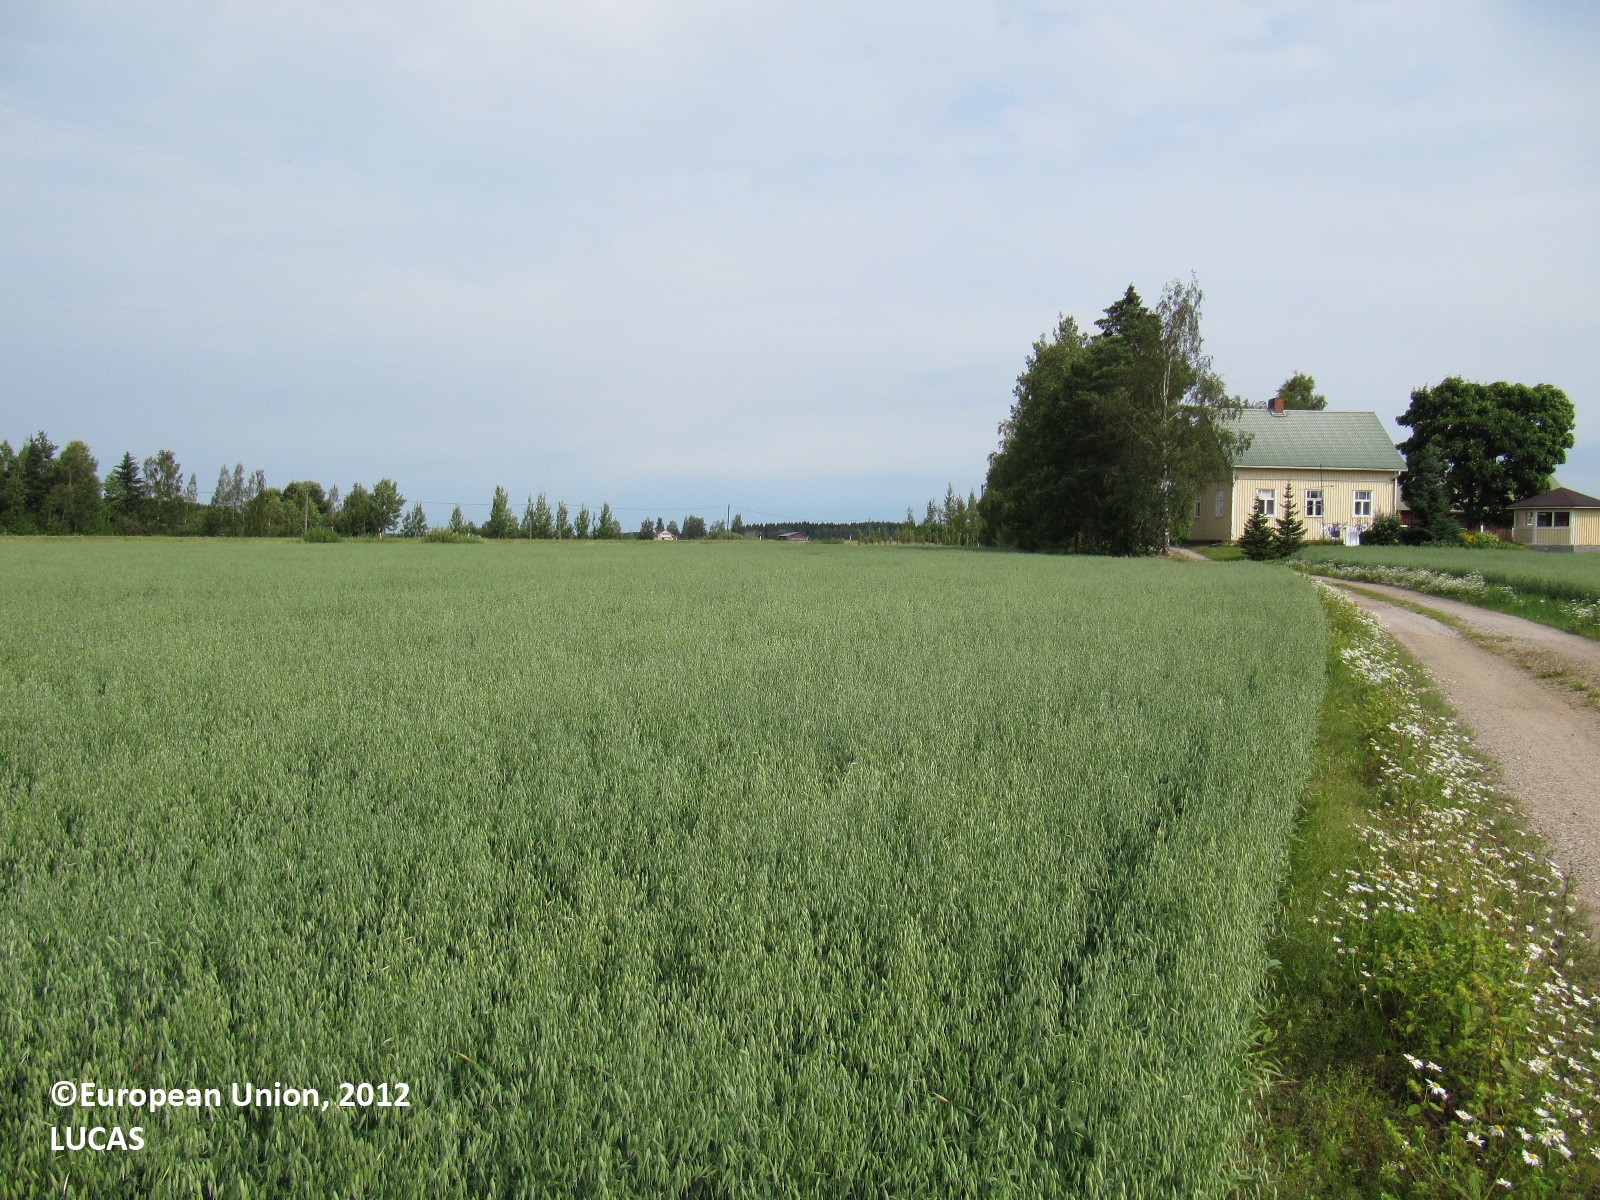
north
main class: Cropland
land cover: Oats
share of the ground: > 75 %
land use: Agriculture (excluding fallow land and kitchen gardens)
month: August
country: FI
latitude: 60.4826
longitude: 23.2748
